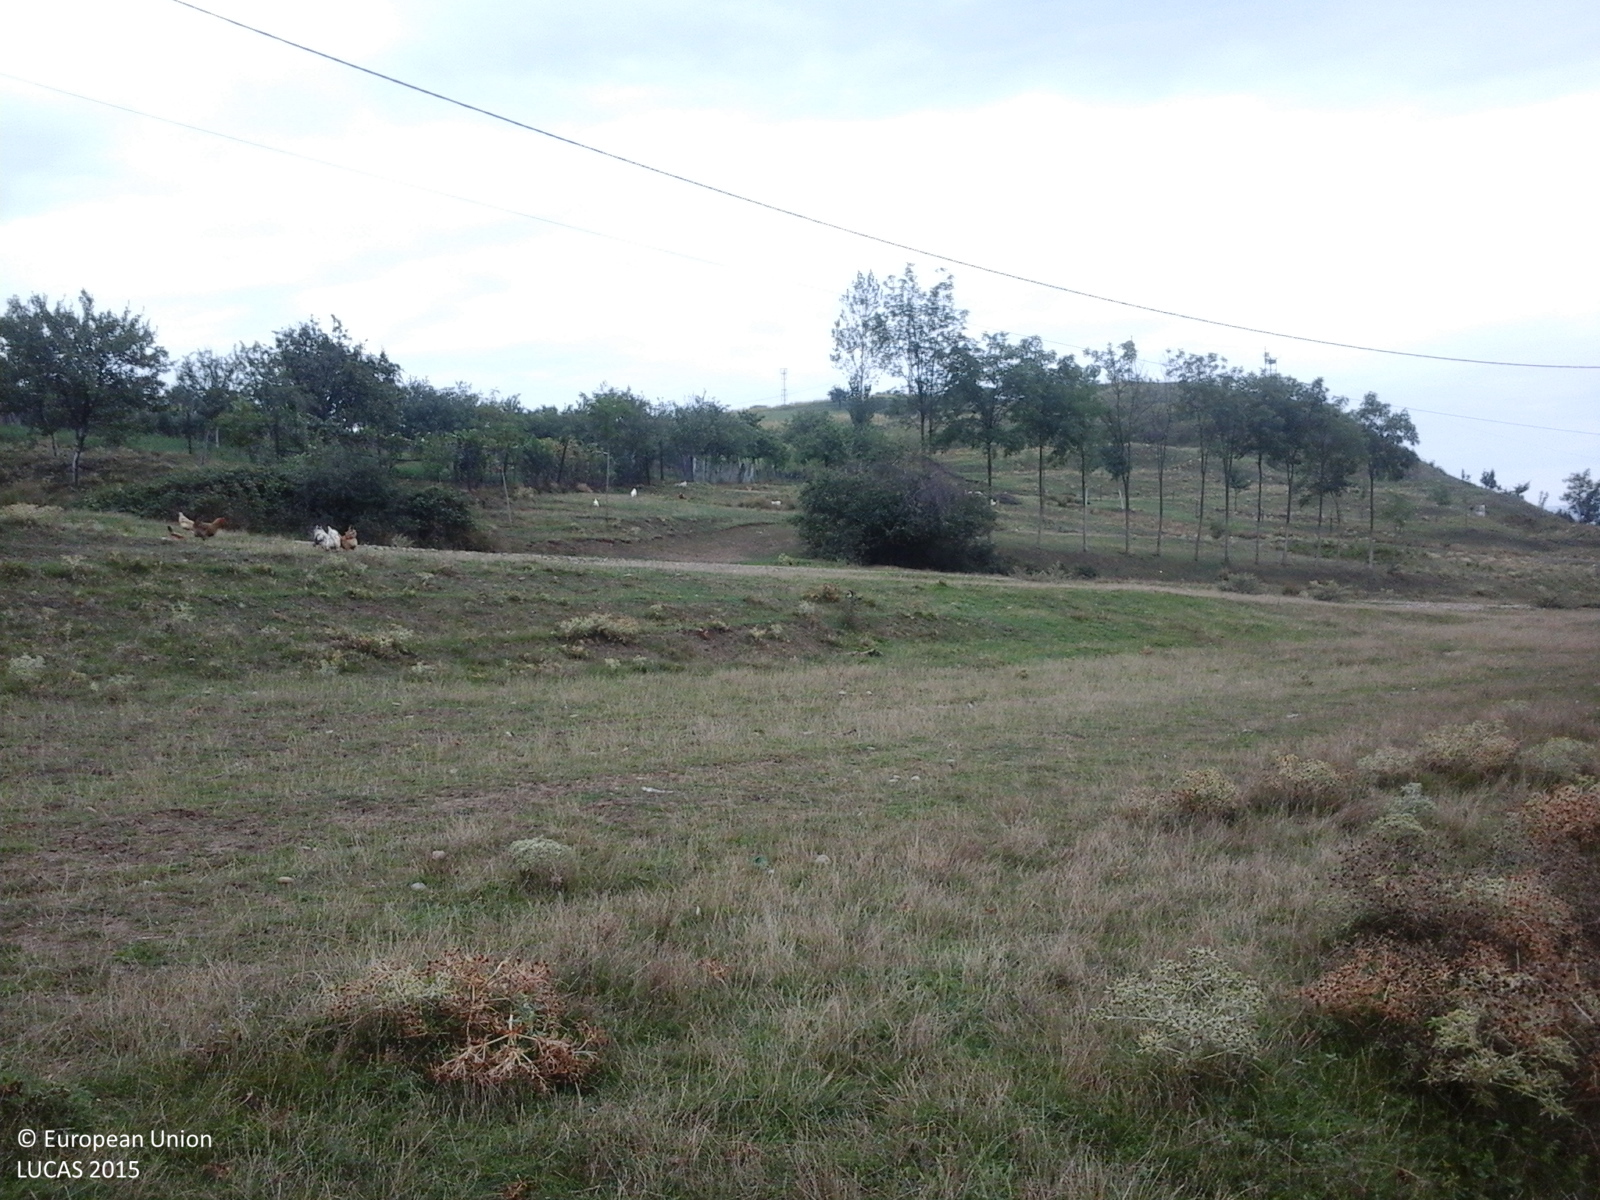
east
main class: Grassland
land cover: Grassland without tree/shrub cover
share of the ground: > 75 %
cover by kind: herbaceous plants 100 %
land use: Agriculture (excluding fallow land and kitchen gardens)
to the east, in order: Grassland without tree/shrub cover; Broadleaved woodland; Grassland without tree/shrub cover; Electric lines; Grassland without tree/shrub cover; Tracks; Grassland without tree/shrub cover; Tracks; Grassland without tree/shrub cover; Fences; Maize; Fences; Other fruit trees and berries; Maize; Durum wheat
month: September
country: RO
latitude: 47.2671
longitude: 22.3855
